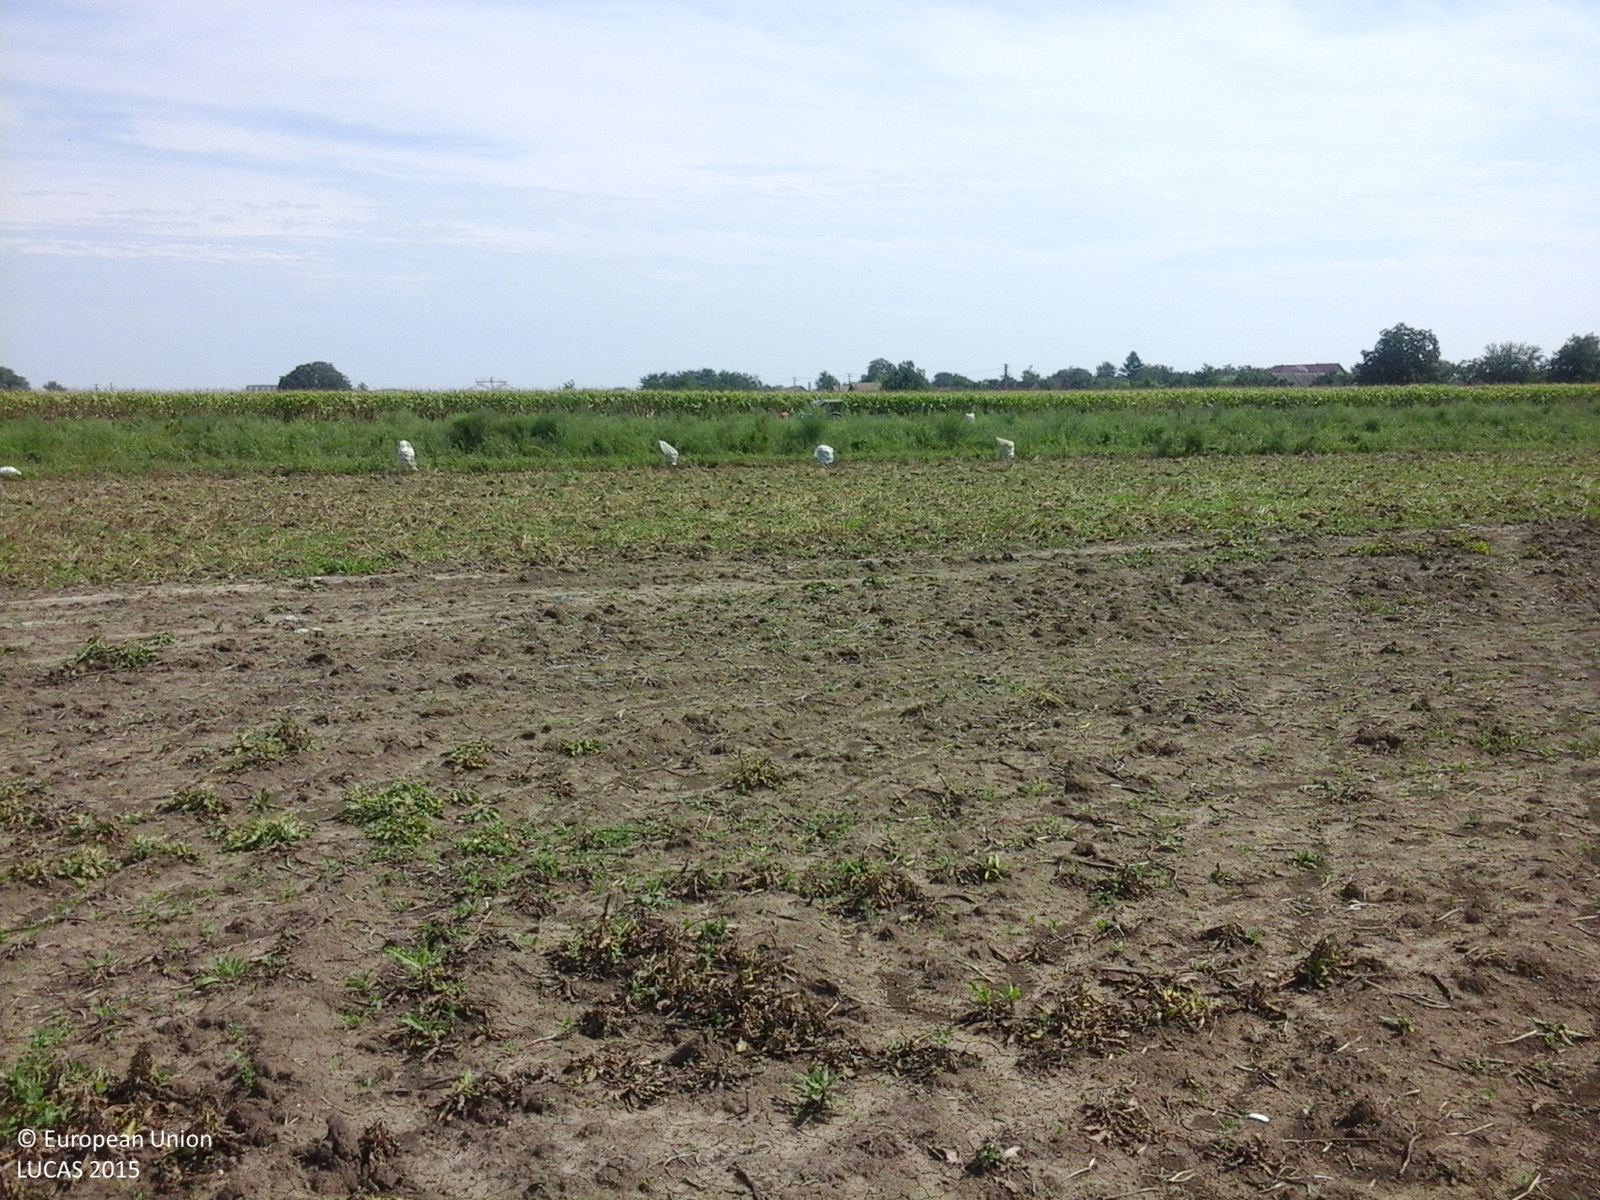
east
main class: Cropland
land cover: Tomatoes
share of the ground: < 10 %
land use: Agriculture (excluding fallow land and kitchen gardens)
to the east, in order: Tomatoes; Arable land (only in case pi)
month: August
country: RO
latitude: 46.1762
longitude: 21.0544
